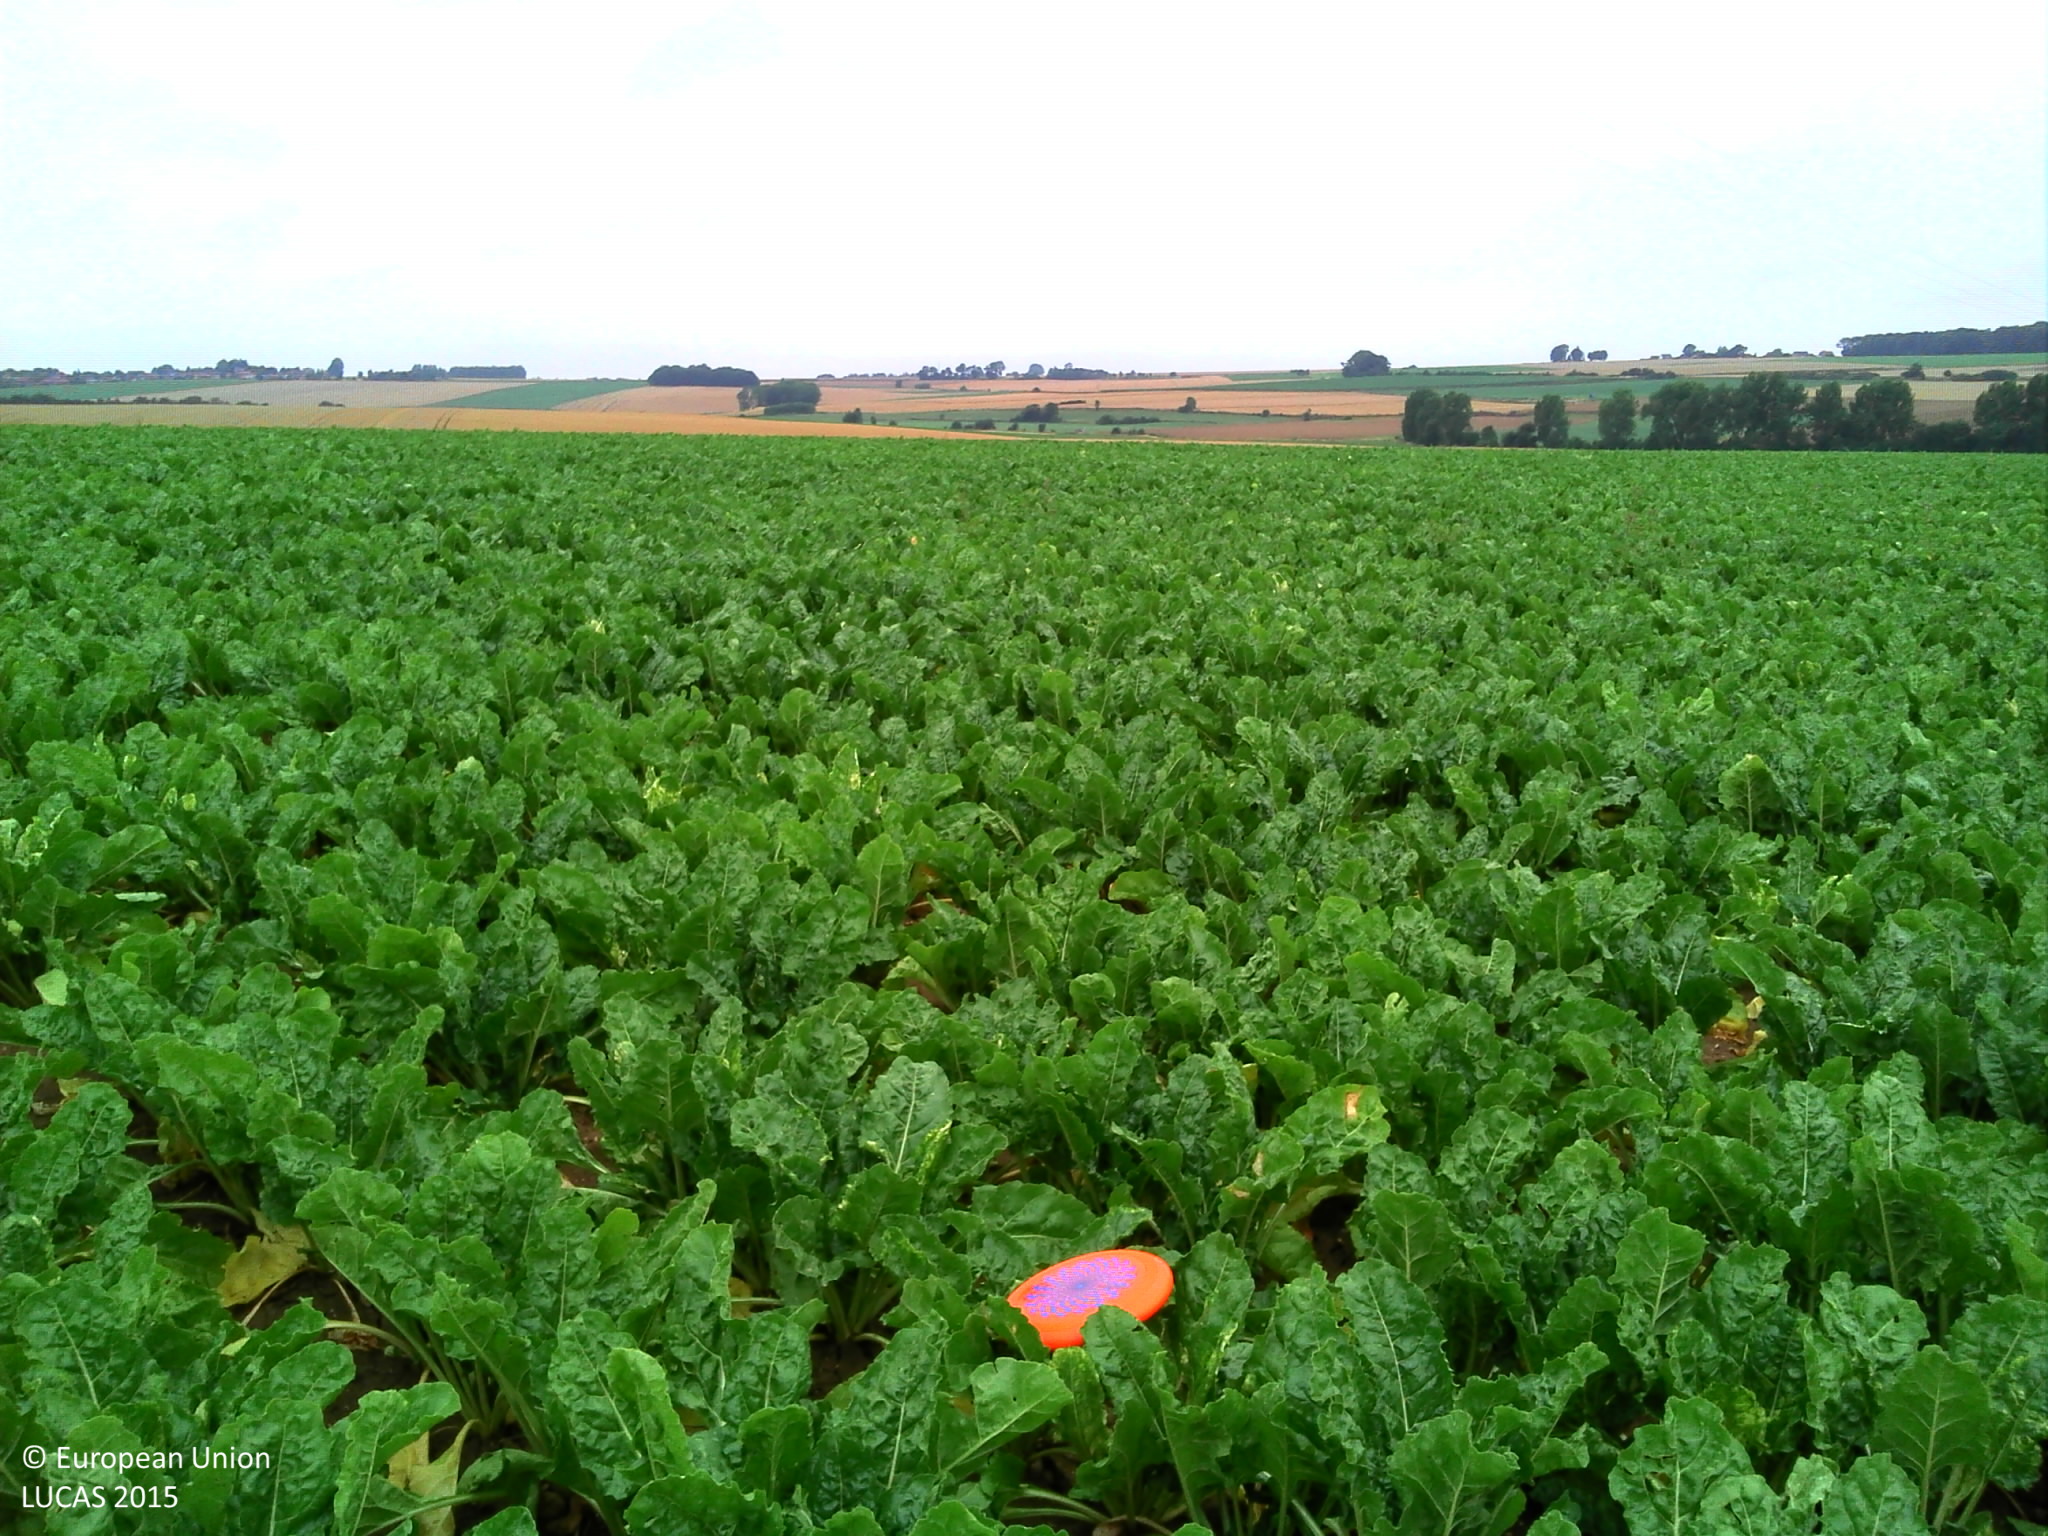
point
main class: Cropland
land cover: Sugar beet
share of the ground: > 75 %
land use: Agriculture (excluding fallow land and kitchen gardens)
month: July
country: FR
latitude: 50.1031
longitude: 3.1260
